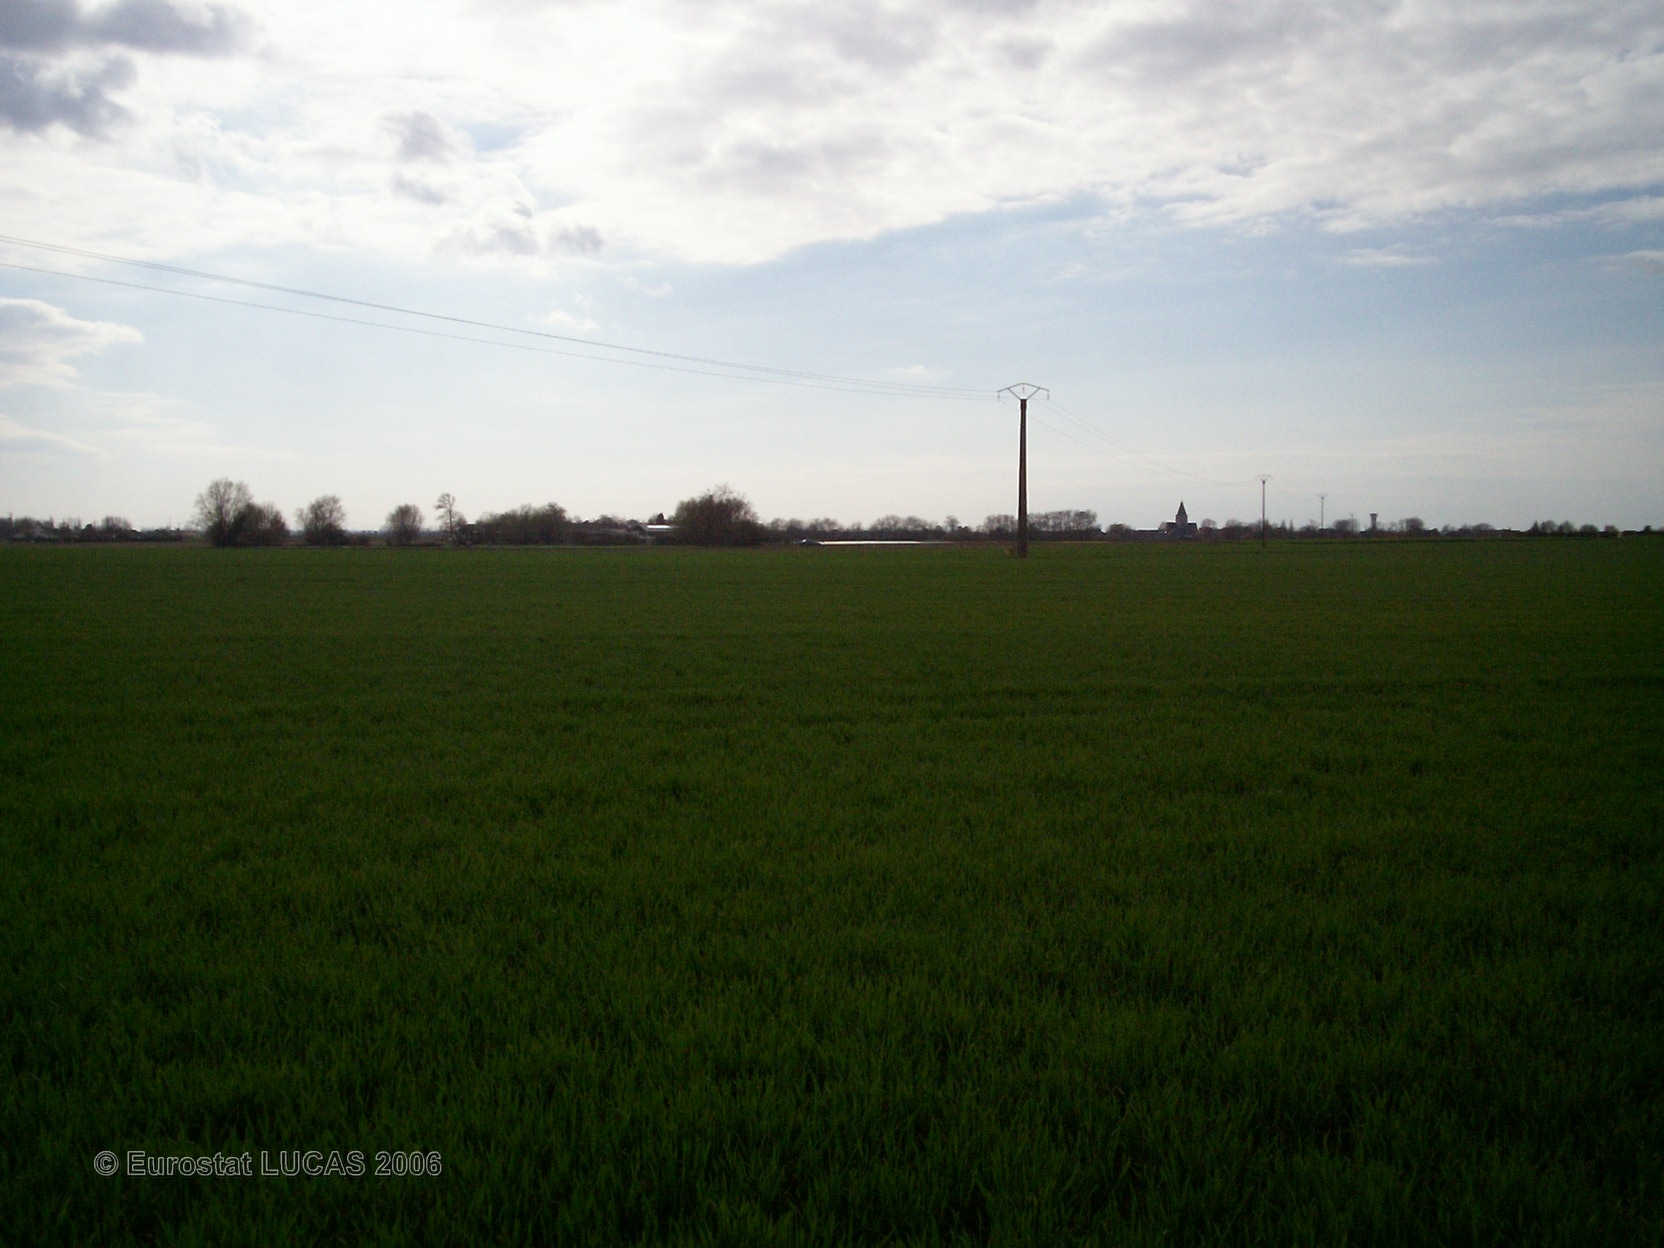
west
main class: Cropland
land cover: Common wheat
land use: Agriculture (excluding fallow land and kitchen gardens)
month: April
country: FR
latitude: 50.8883
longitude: 2.4098
